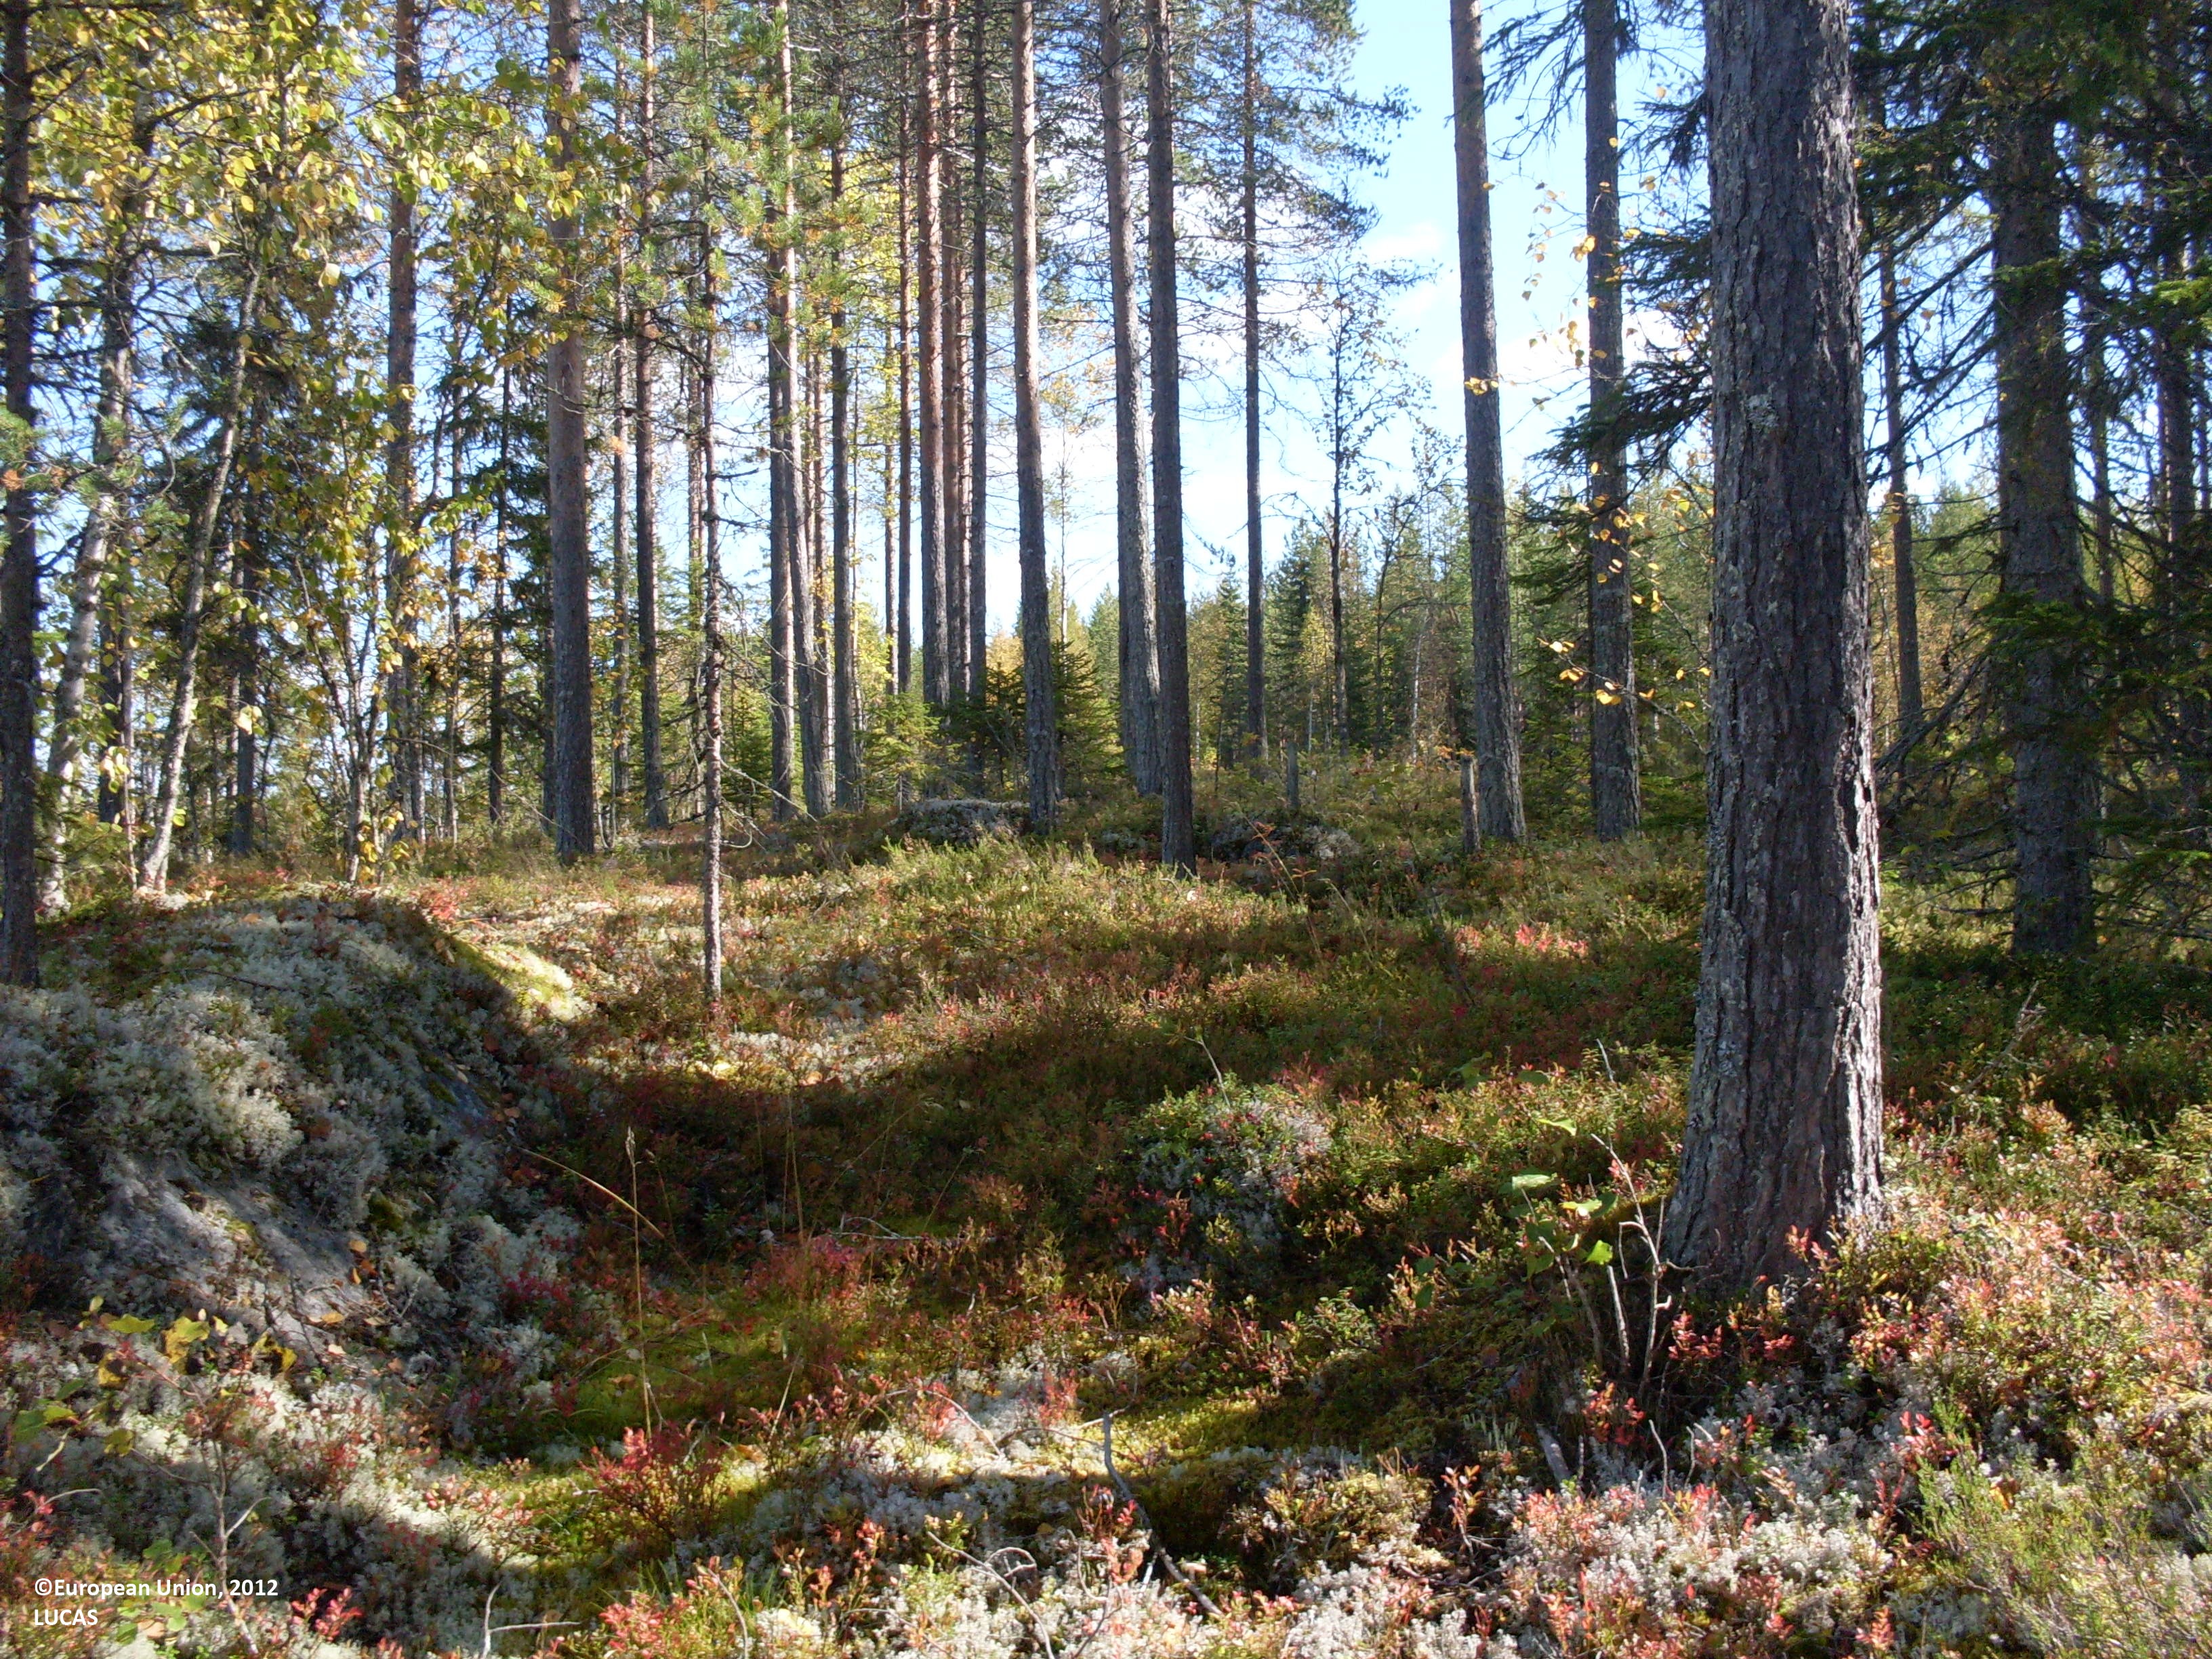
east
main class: Woodland
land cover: Pine dominated coniferous woodland
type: boreal forest
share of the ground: 50 - 75 %
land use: Forestry
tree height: > 5 m
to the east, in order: Pine dominated coniferous woodland; Pine dominated mixed woodland; Spontaneously vegetated surfaces; Pine dominated mixed woodland
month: September
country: FI
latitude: 64.1023
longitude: 29.9584
